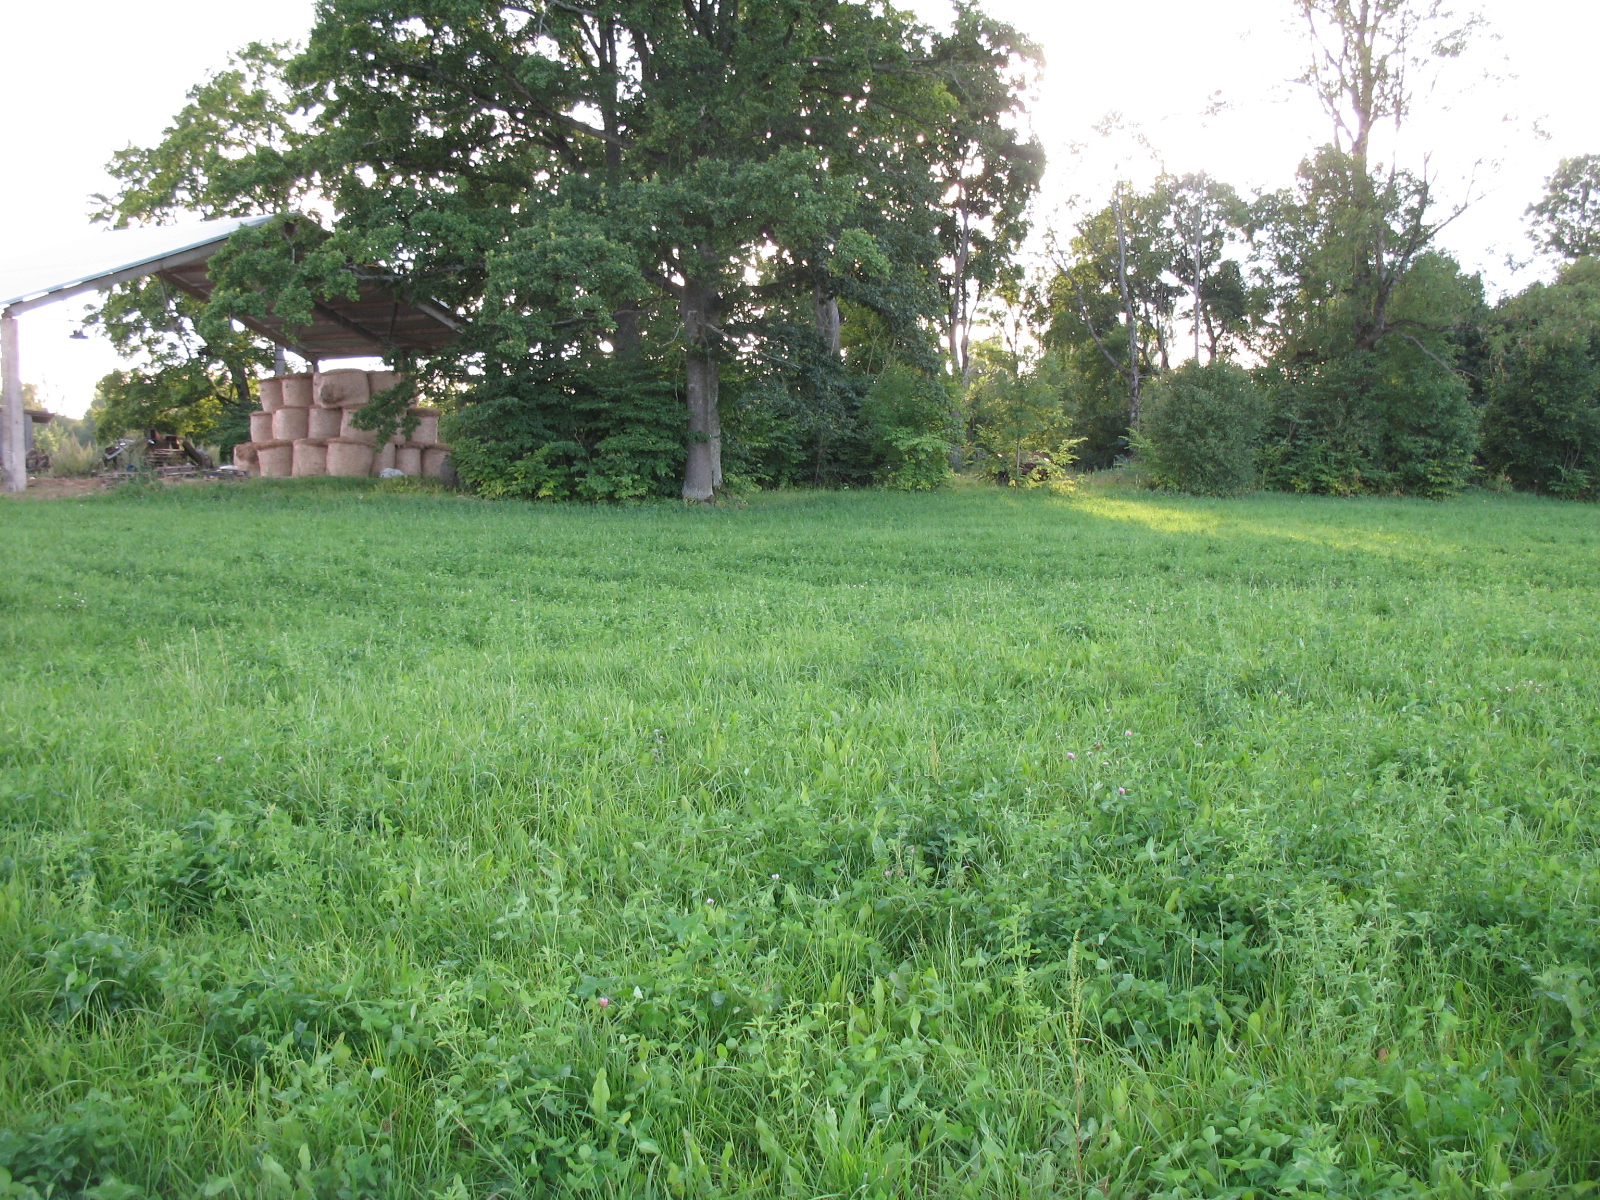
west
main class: Grassland
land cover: Grassland without tree/shrub cover
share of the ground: > 75 %
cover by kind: herbaceous plants 100 %
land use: Agriculture (excluding fallow land and kitchen gardens)
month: August
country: LV
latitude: 56.2894
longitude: 25.4518
